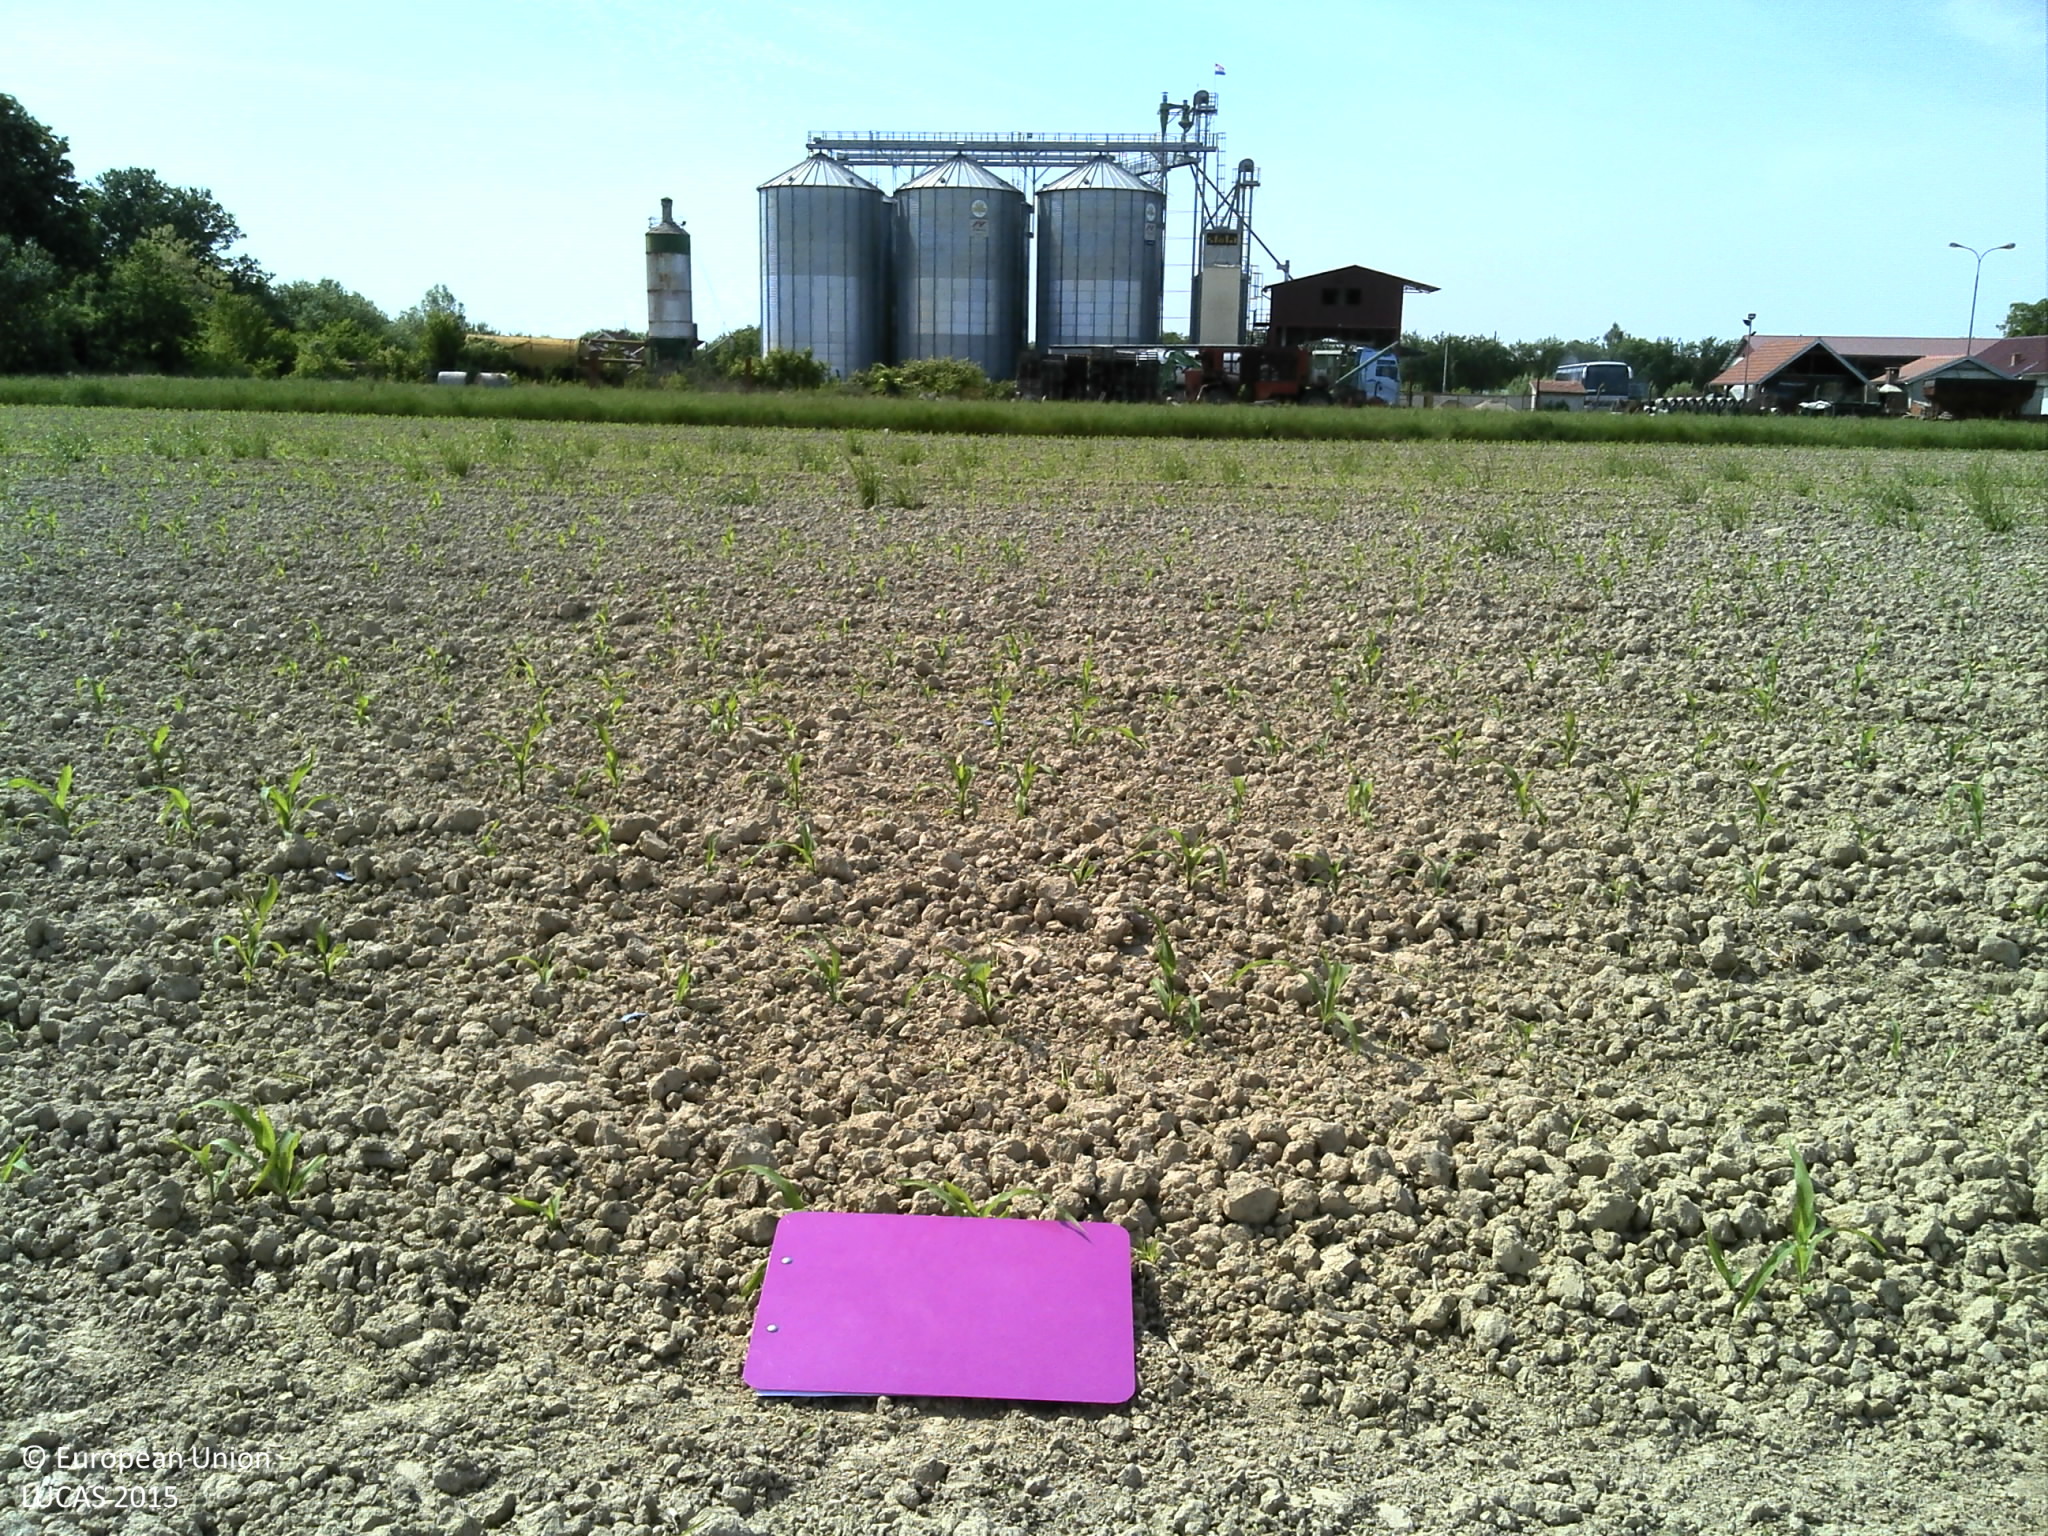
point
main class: Cropland
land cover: Maize
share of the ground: < 10 %
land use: Agriculture (excluding fallow land and kitchen gardens)
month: May
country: HR
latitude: 45.5757
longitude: 18.0649
